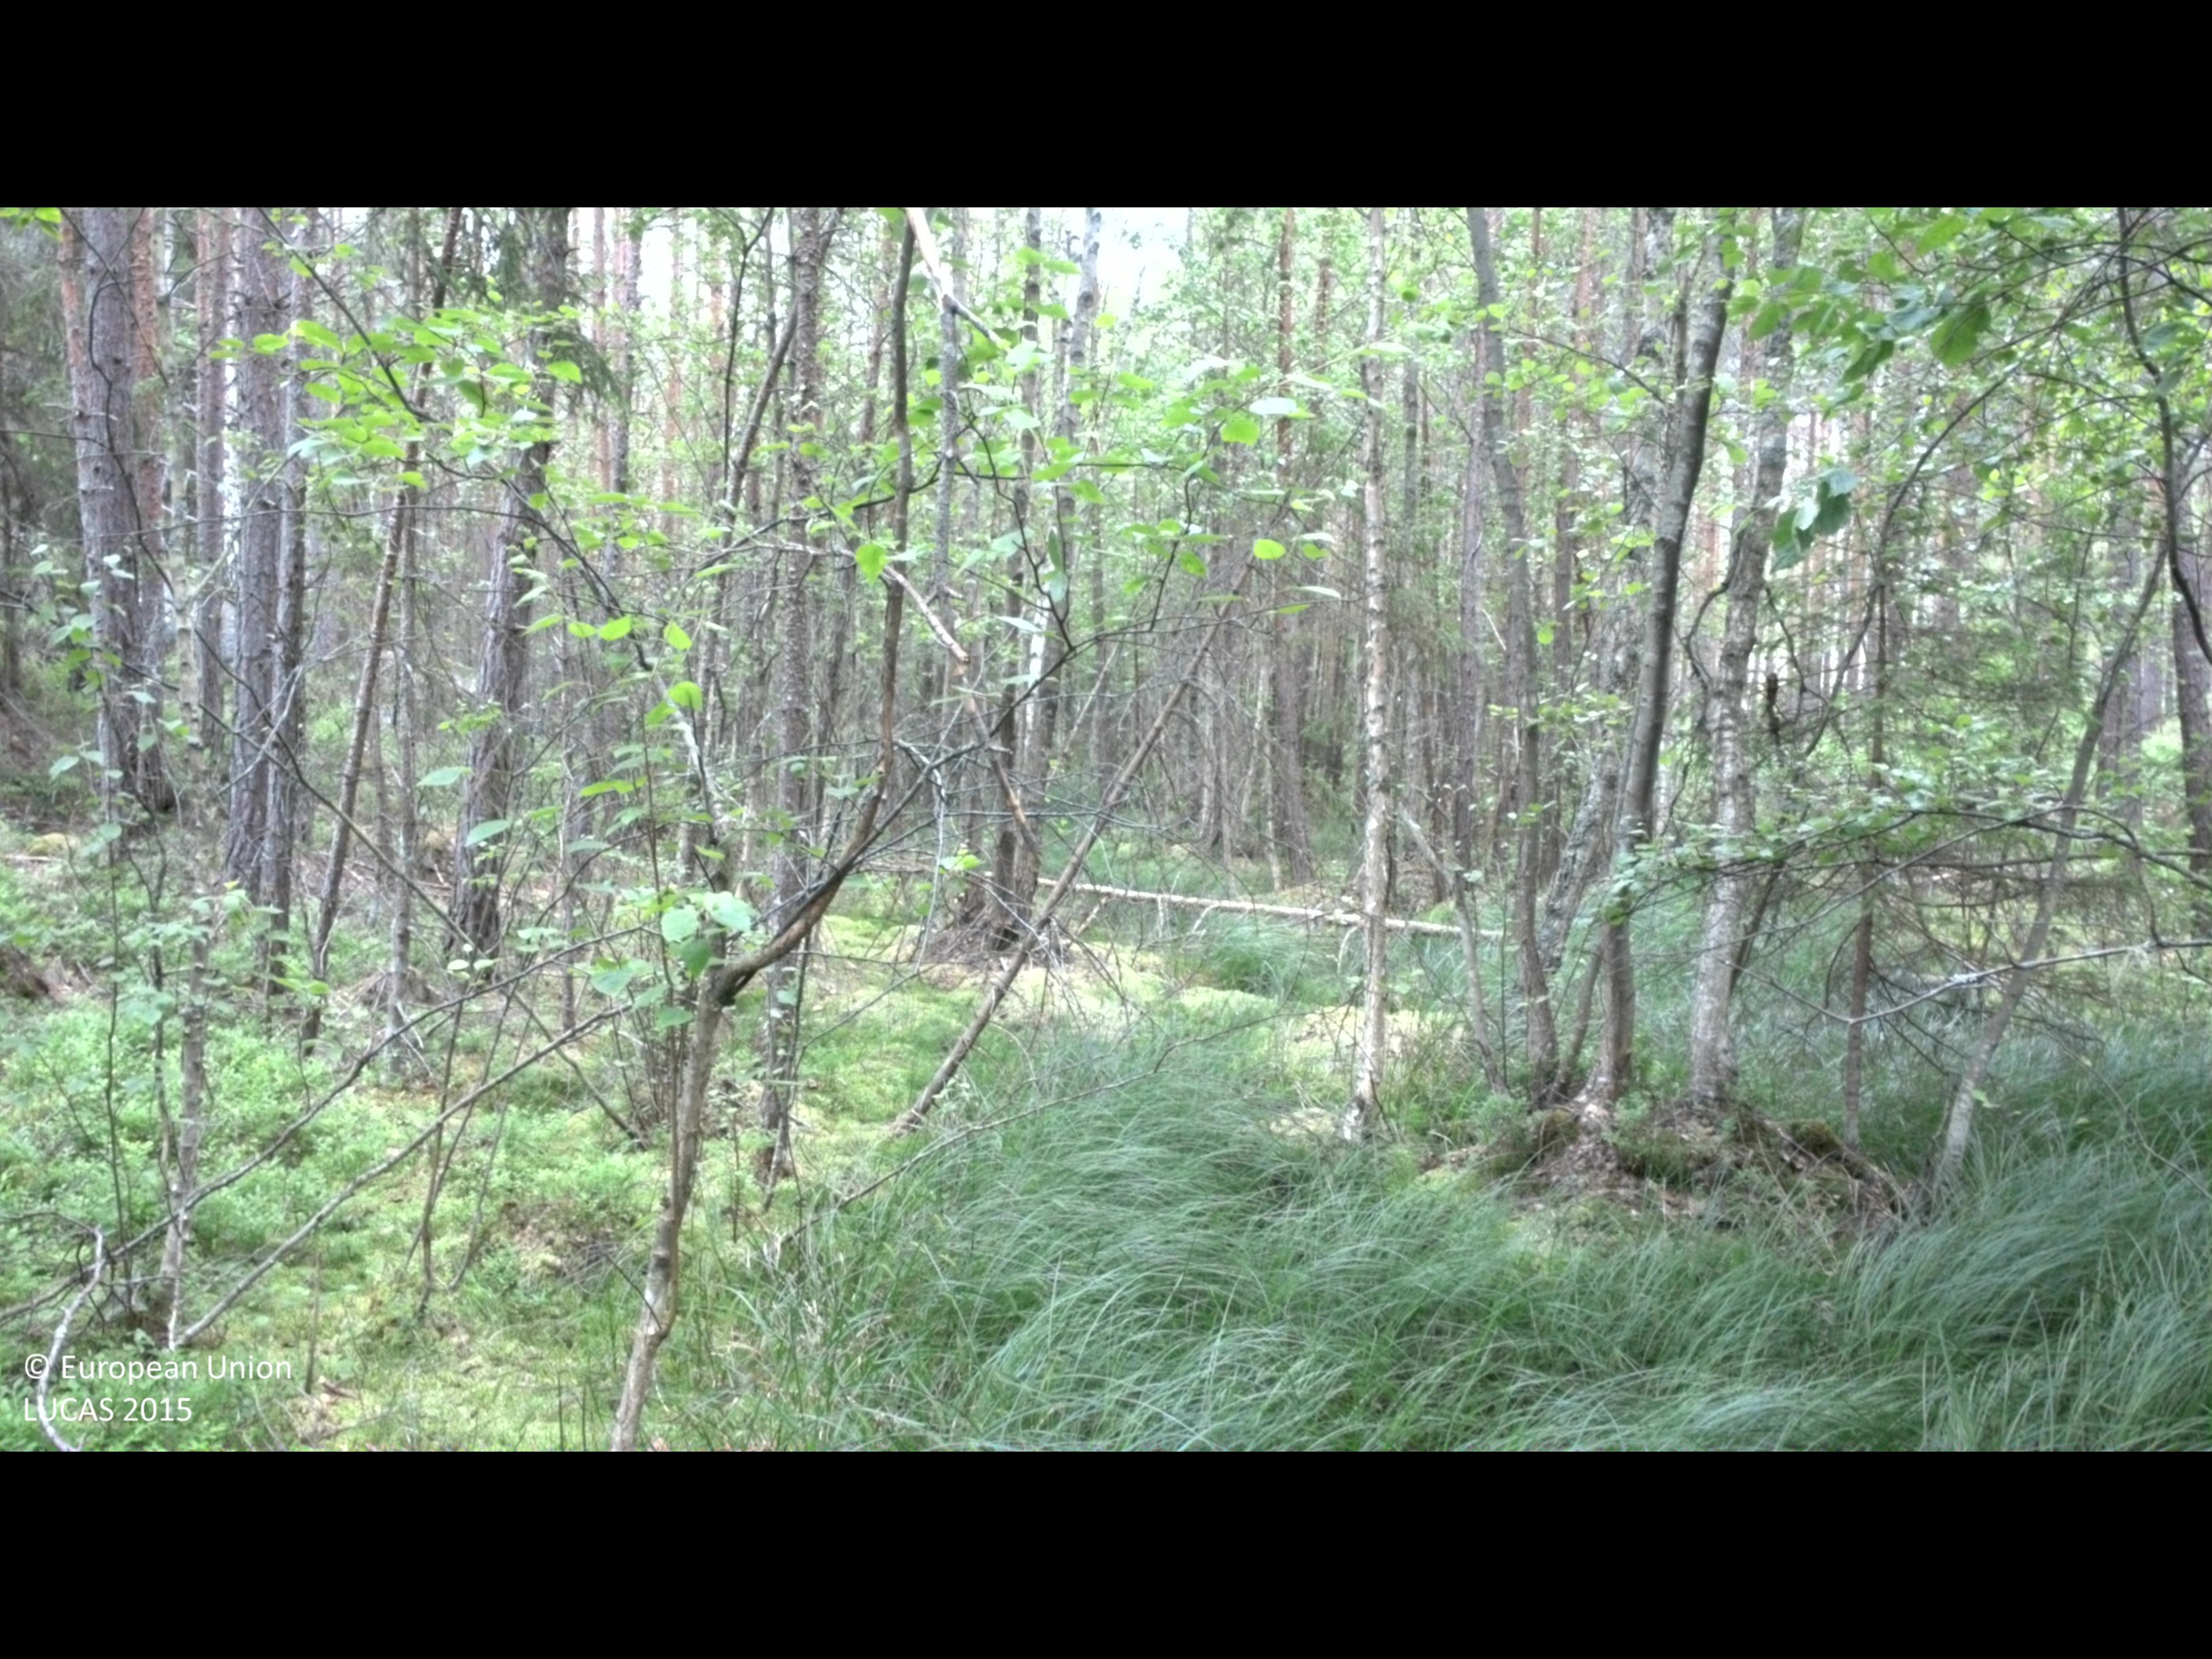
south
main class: Woodland
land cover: Pine dominated mixed woodland
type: boreal forest
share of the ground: > 75 %
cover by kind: coniferous forest trees 50 %, broadleaved forest trees 25 %, shrubs 15 %, herbaceous plants 5 %, lichens and mosses 5 %
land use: Forestry
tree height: > 5 m
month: June
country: SE
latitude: 57.9684
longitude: 16.5738
